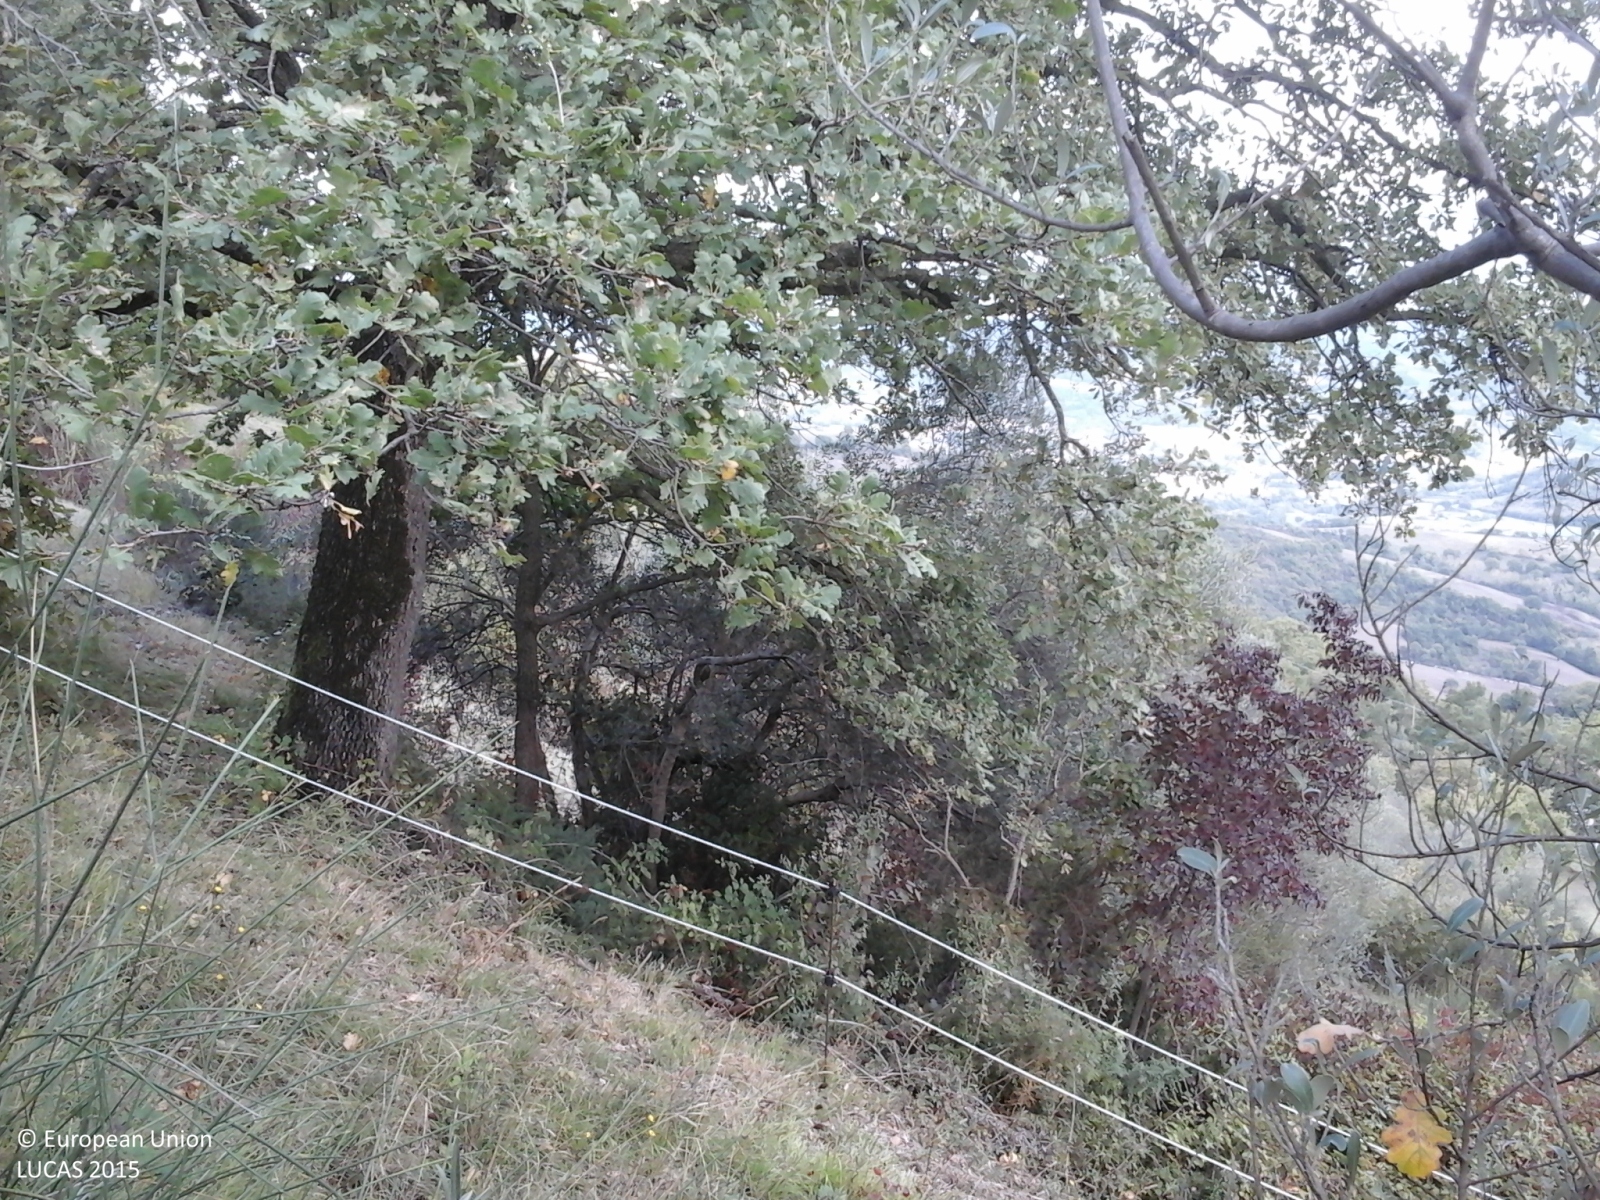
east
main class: Cropland
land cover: Olive groves
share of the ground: 25 - 50 %
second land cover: Shrubland without tree cover
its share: > 75 %
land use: Abandoned areas
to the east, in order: Olive groves; Shrubland without tree cover; Electric lines; Fences; Abandoned hedges; Olive groves; Grassland with sparse tree/shrub cover
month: October
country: IT
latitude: 43.1636
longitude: 12.5633
